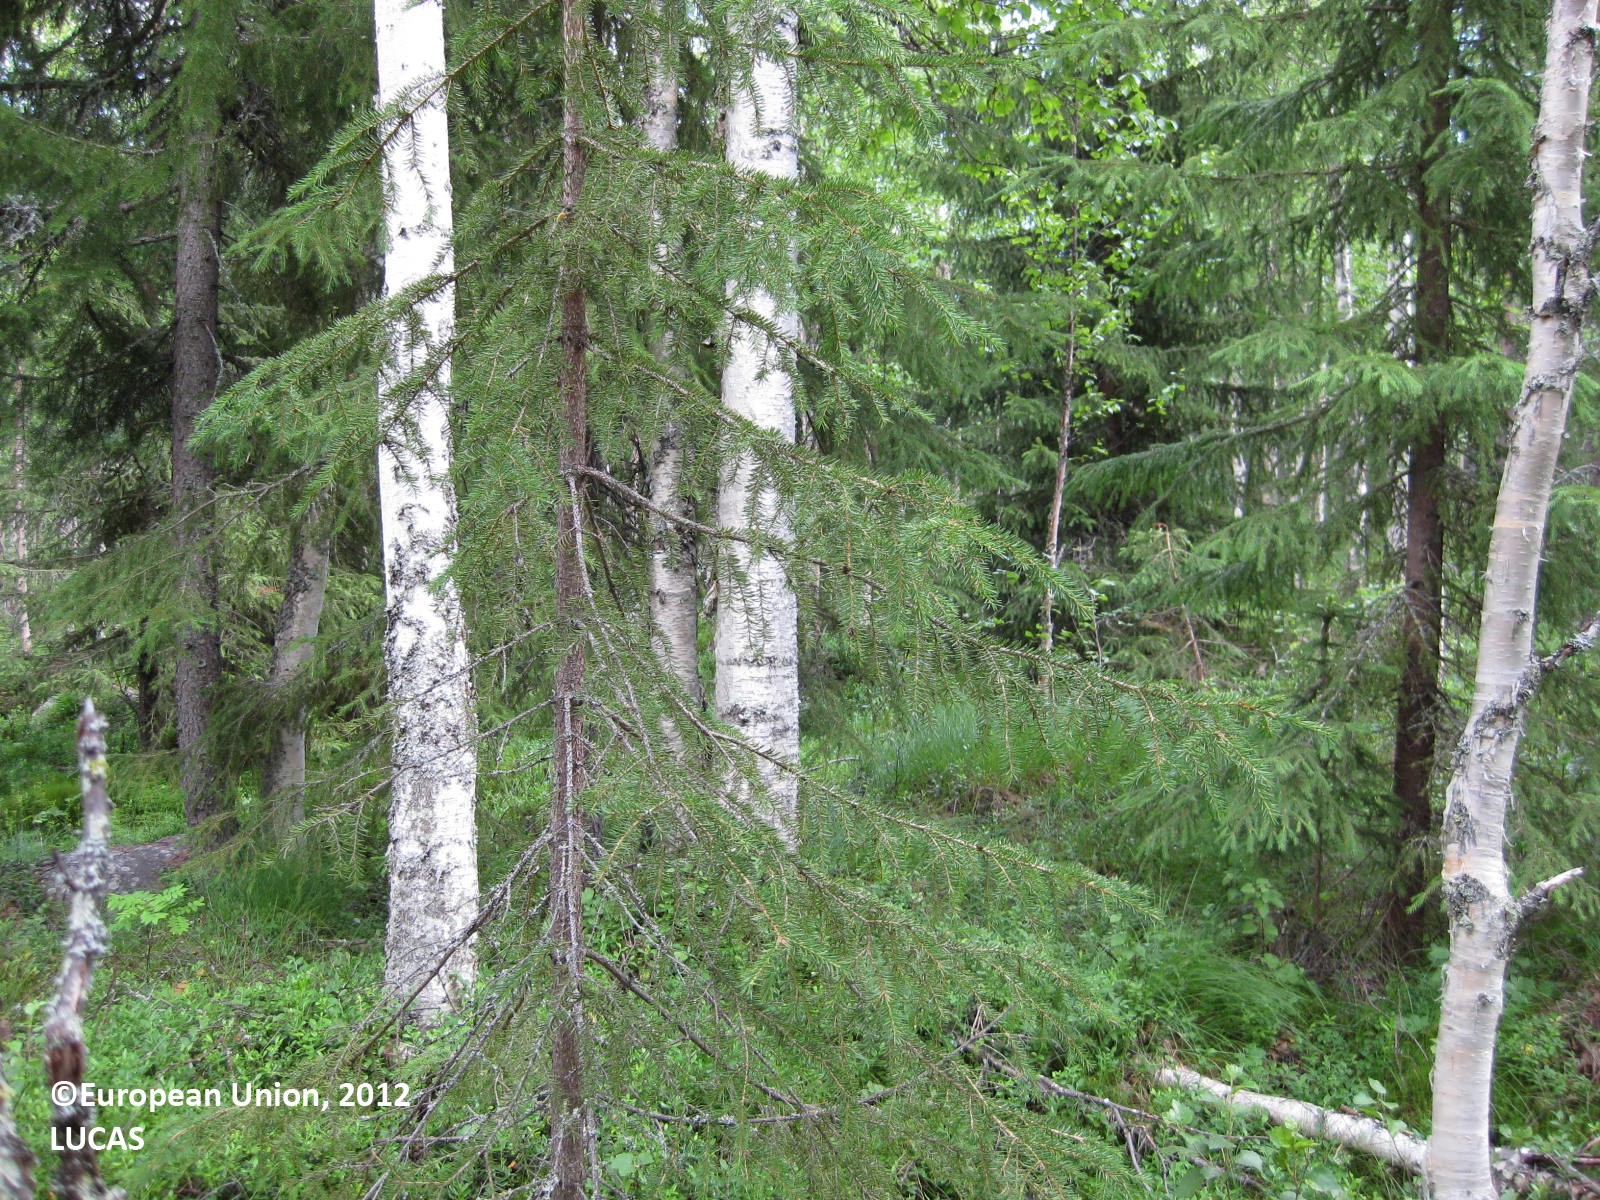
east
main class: Woodland
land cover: Other mixed woodland
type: boreal forest
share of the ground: > 75 %
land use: Forestry
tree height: > 5 m
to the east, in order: Other mixed woodland; Ditches and canals; Other mixed woodland; Ditches and canals; Other mixed woodland; Ditches and canals; Other mixed woodland; Ditches and canals; Other coniferous woodland; Other mixed woodland; Ditches and canals; Other mixed woodland; Ditches and canals; Spruce dominated mixed woodland; Abandoned hedges; Inland running water; Grass margins; Broadleaved woodland
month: July
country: FI
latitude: 65.6861
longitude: 28.5079
